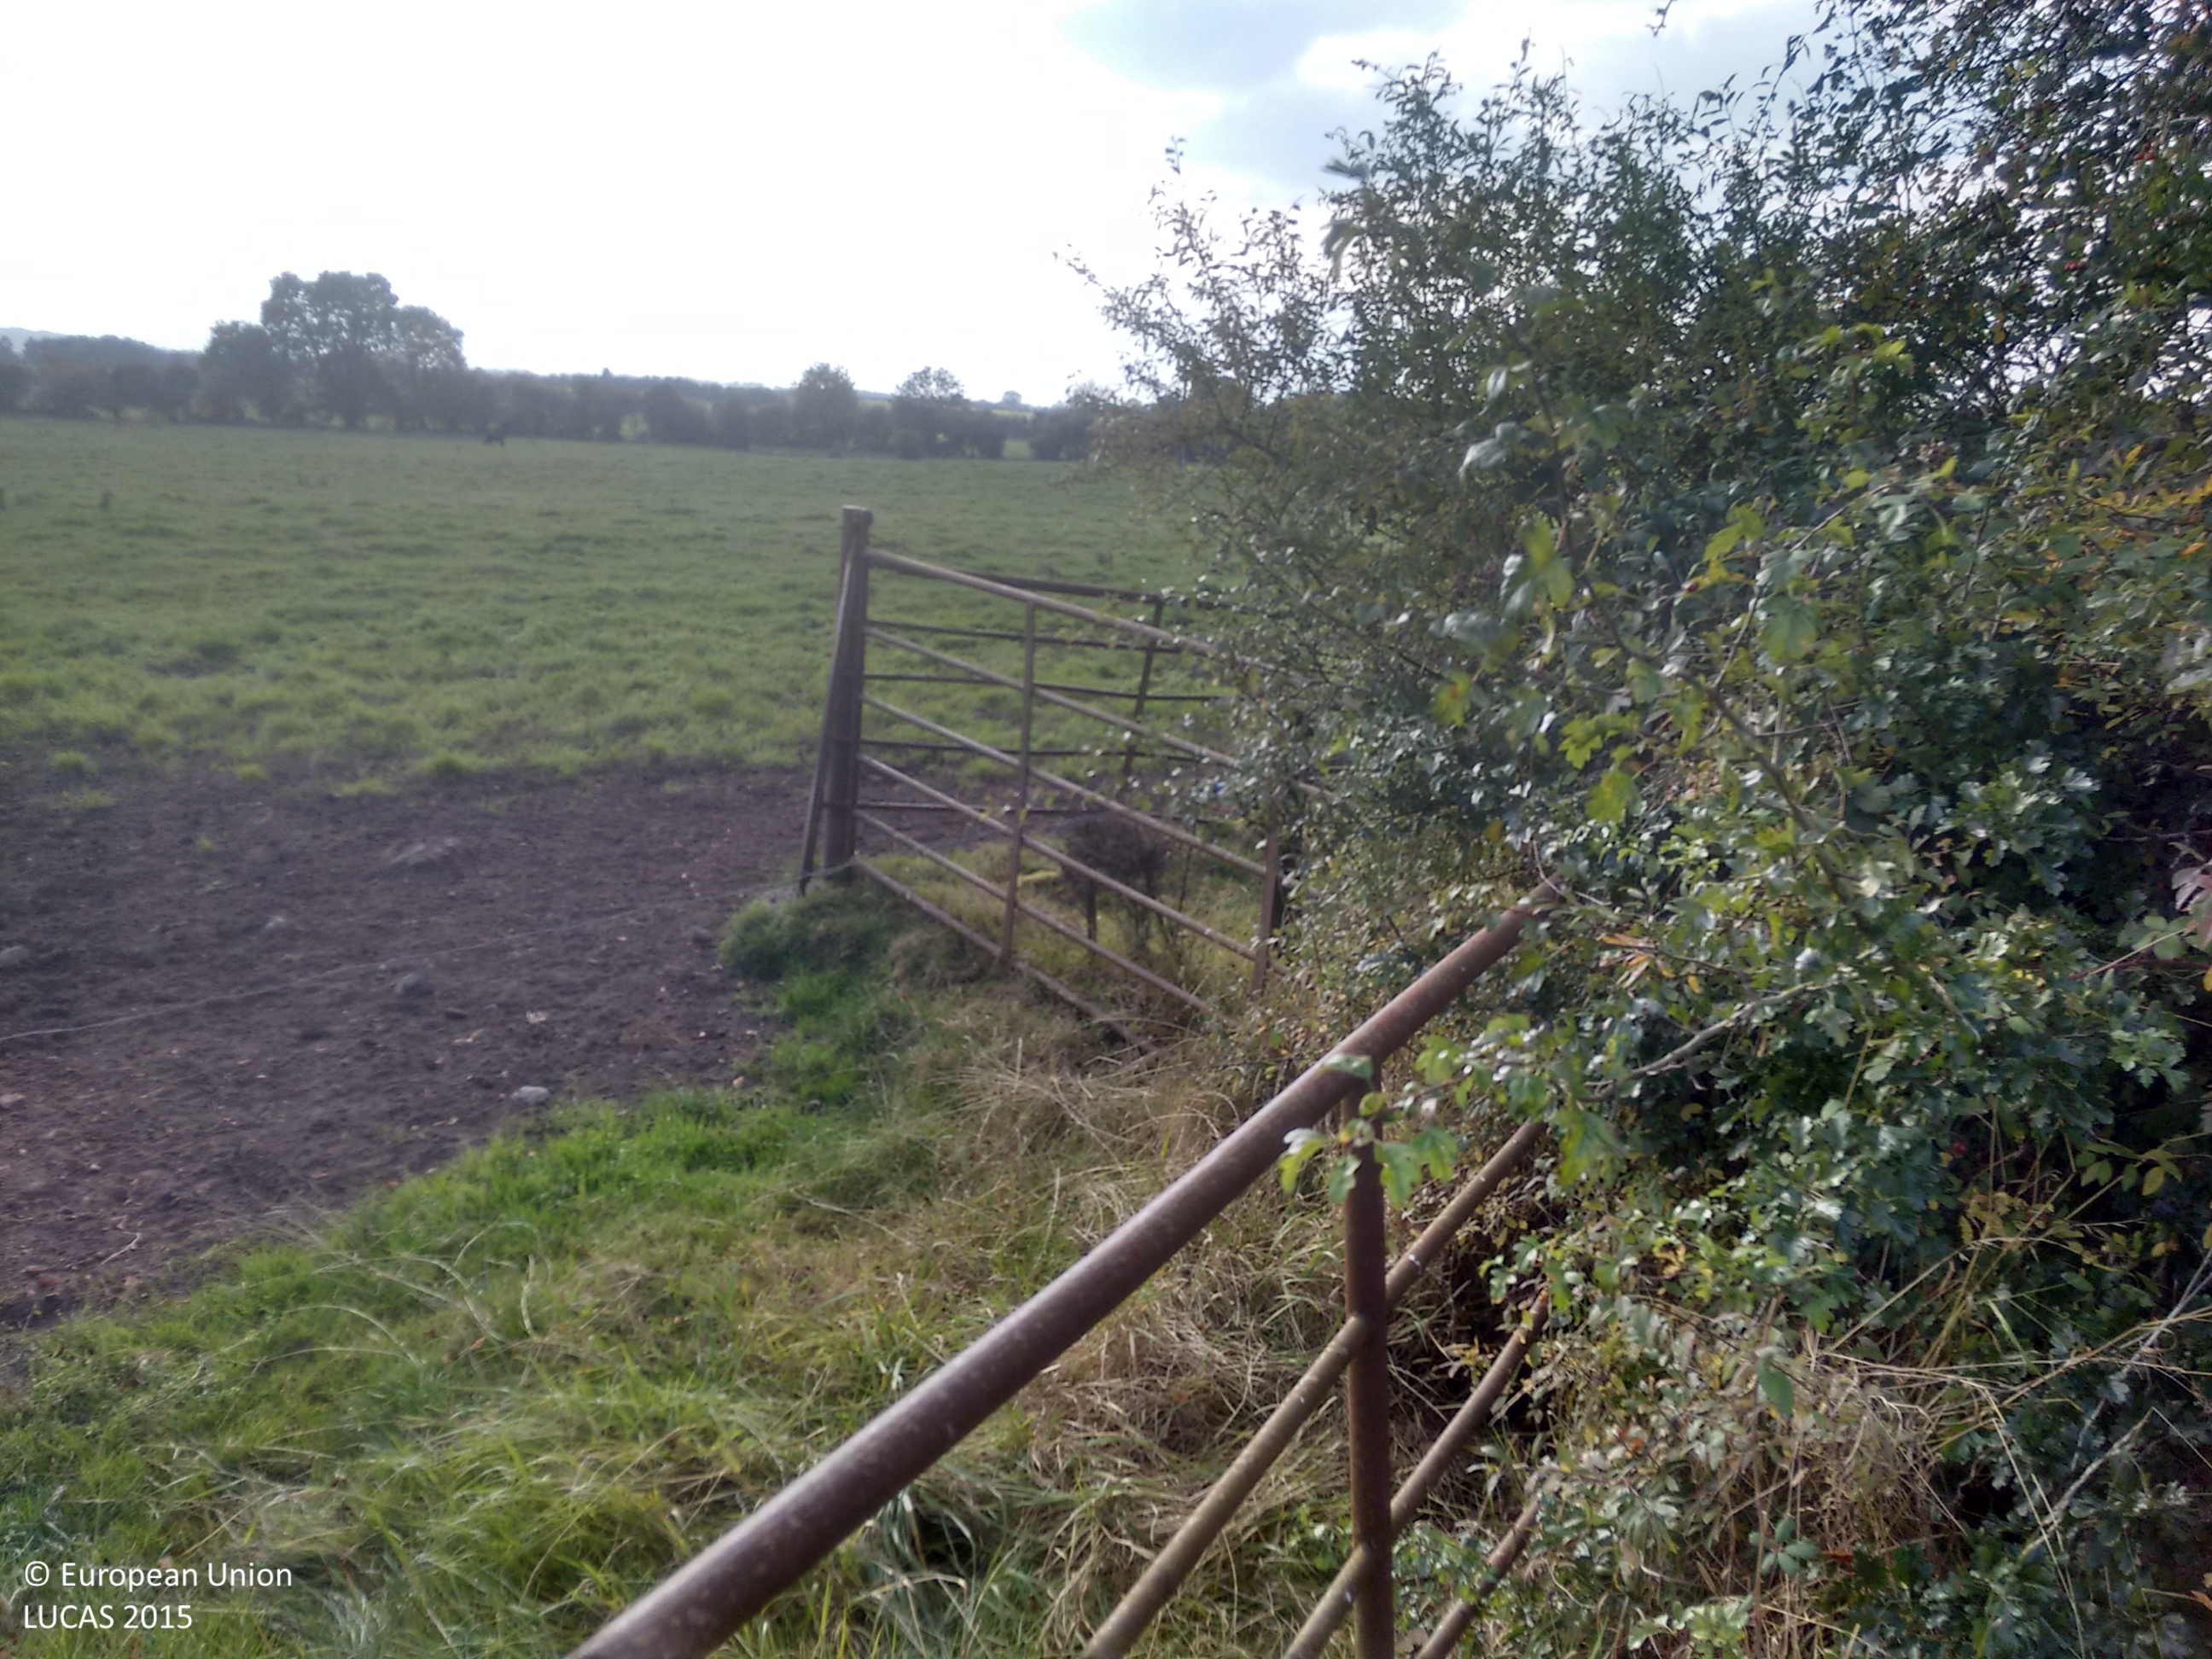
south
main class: Grassland
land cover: Grassland without tree/shrub cover
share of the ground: > 75 %
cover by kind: herbaceous plants 100 %
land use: Agriculture (excluding fallow land and kitchen gardens)
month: October
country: IE
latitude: 52.8343
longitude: -7.6036
